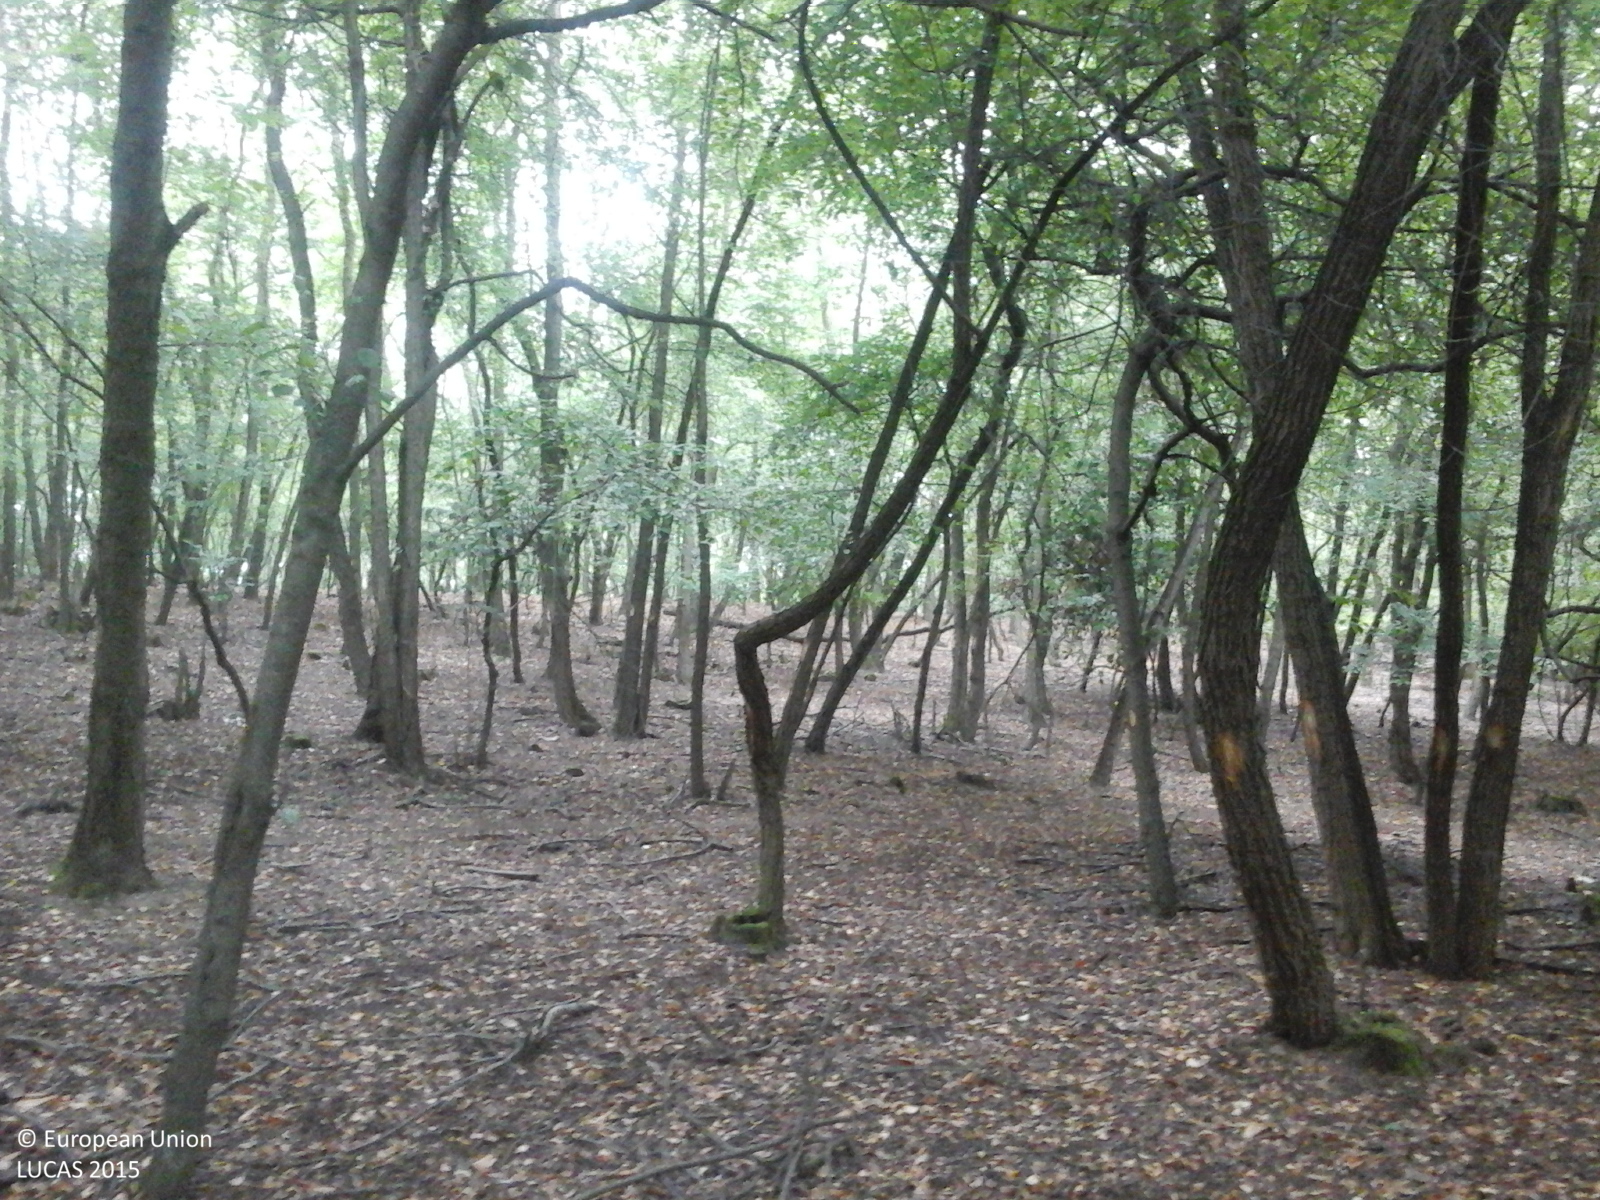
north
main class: Woodland
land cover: Broadleaved woodland
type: exotic forest
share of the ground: > 75 %
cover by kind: broadleaved forest trees 100 %
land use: Forestry
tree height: > 5 m
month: September
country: RO
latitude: 47.5035
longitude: 22.0654
